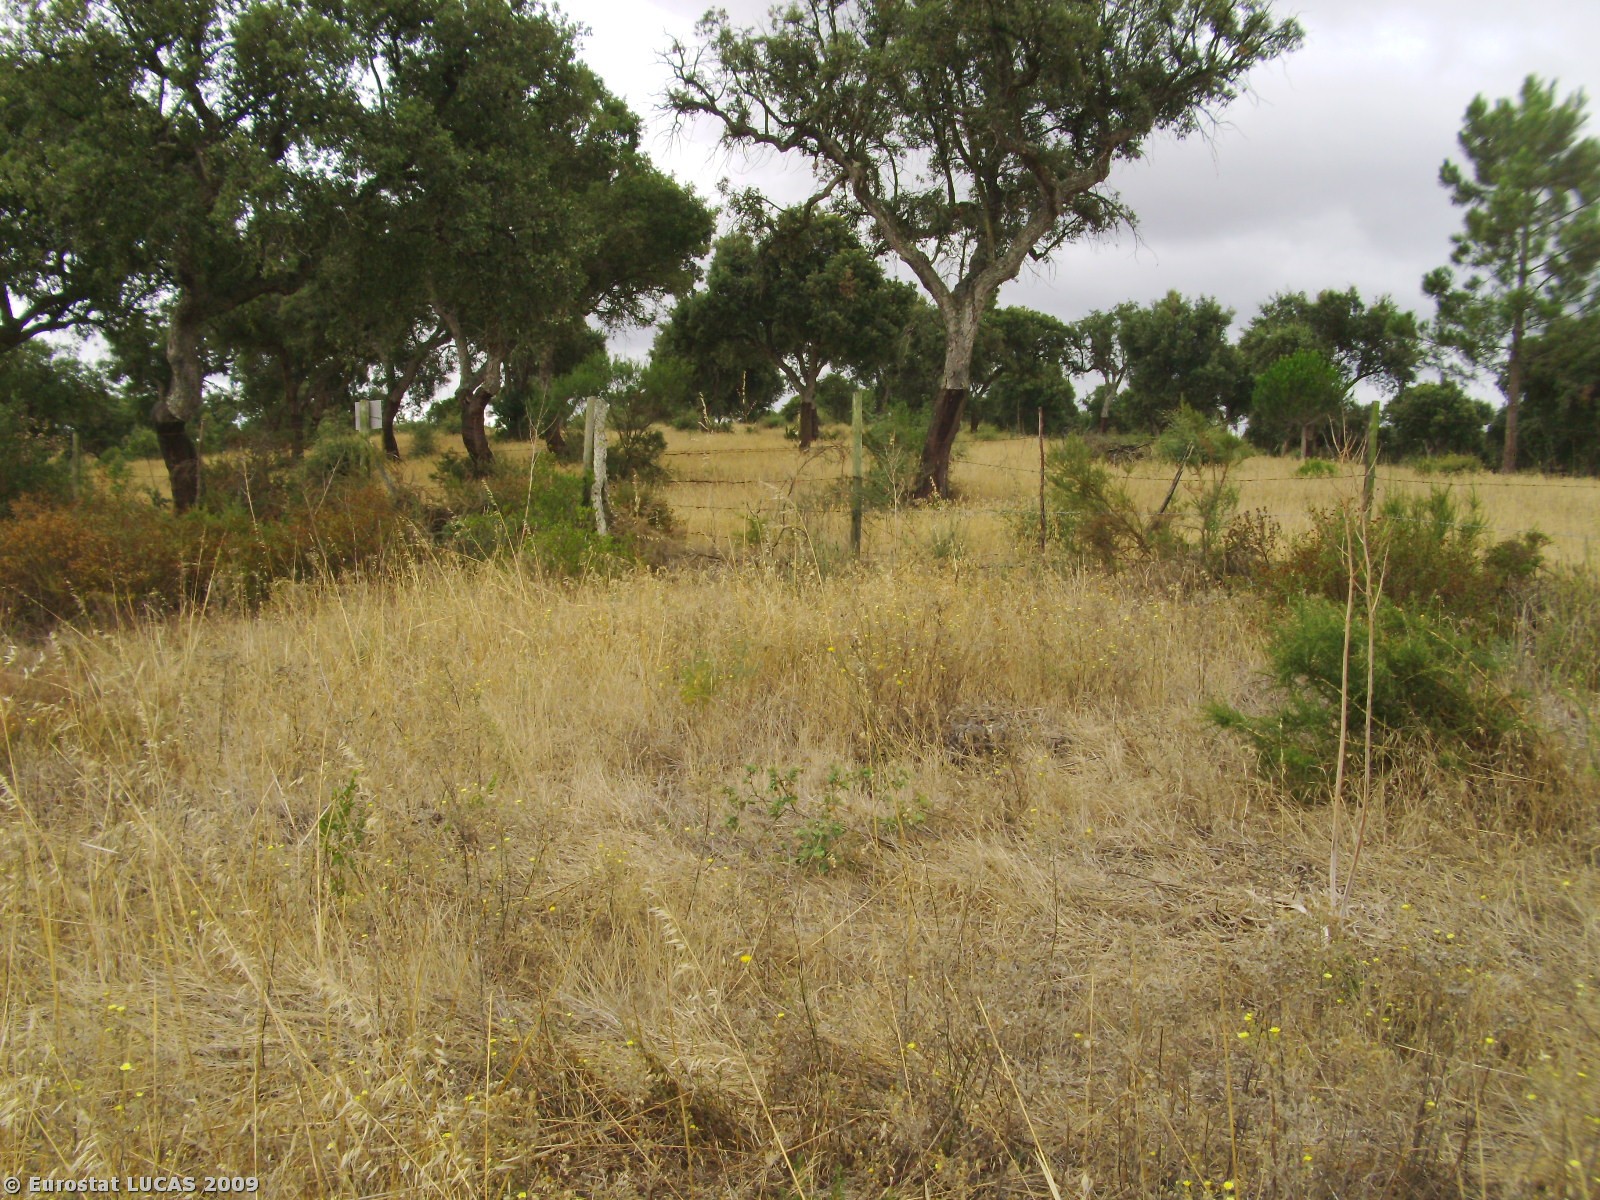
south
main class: Grassland
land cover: Spontaneously vegetated surfaces
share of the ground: > 75 %
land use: Fallow land
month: July
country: PT
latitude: 38.9373
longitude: -8.7698
